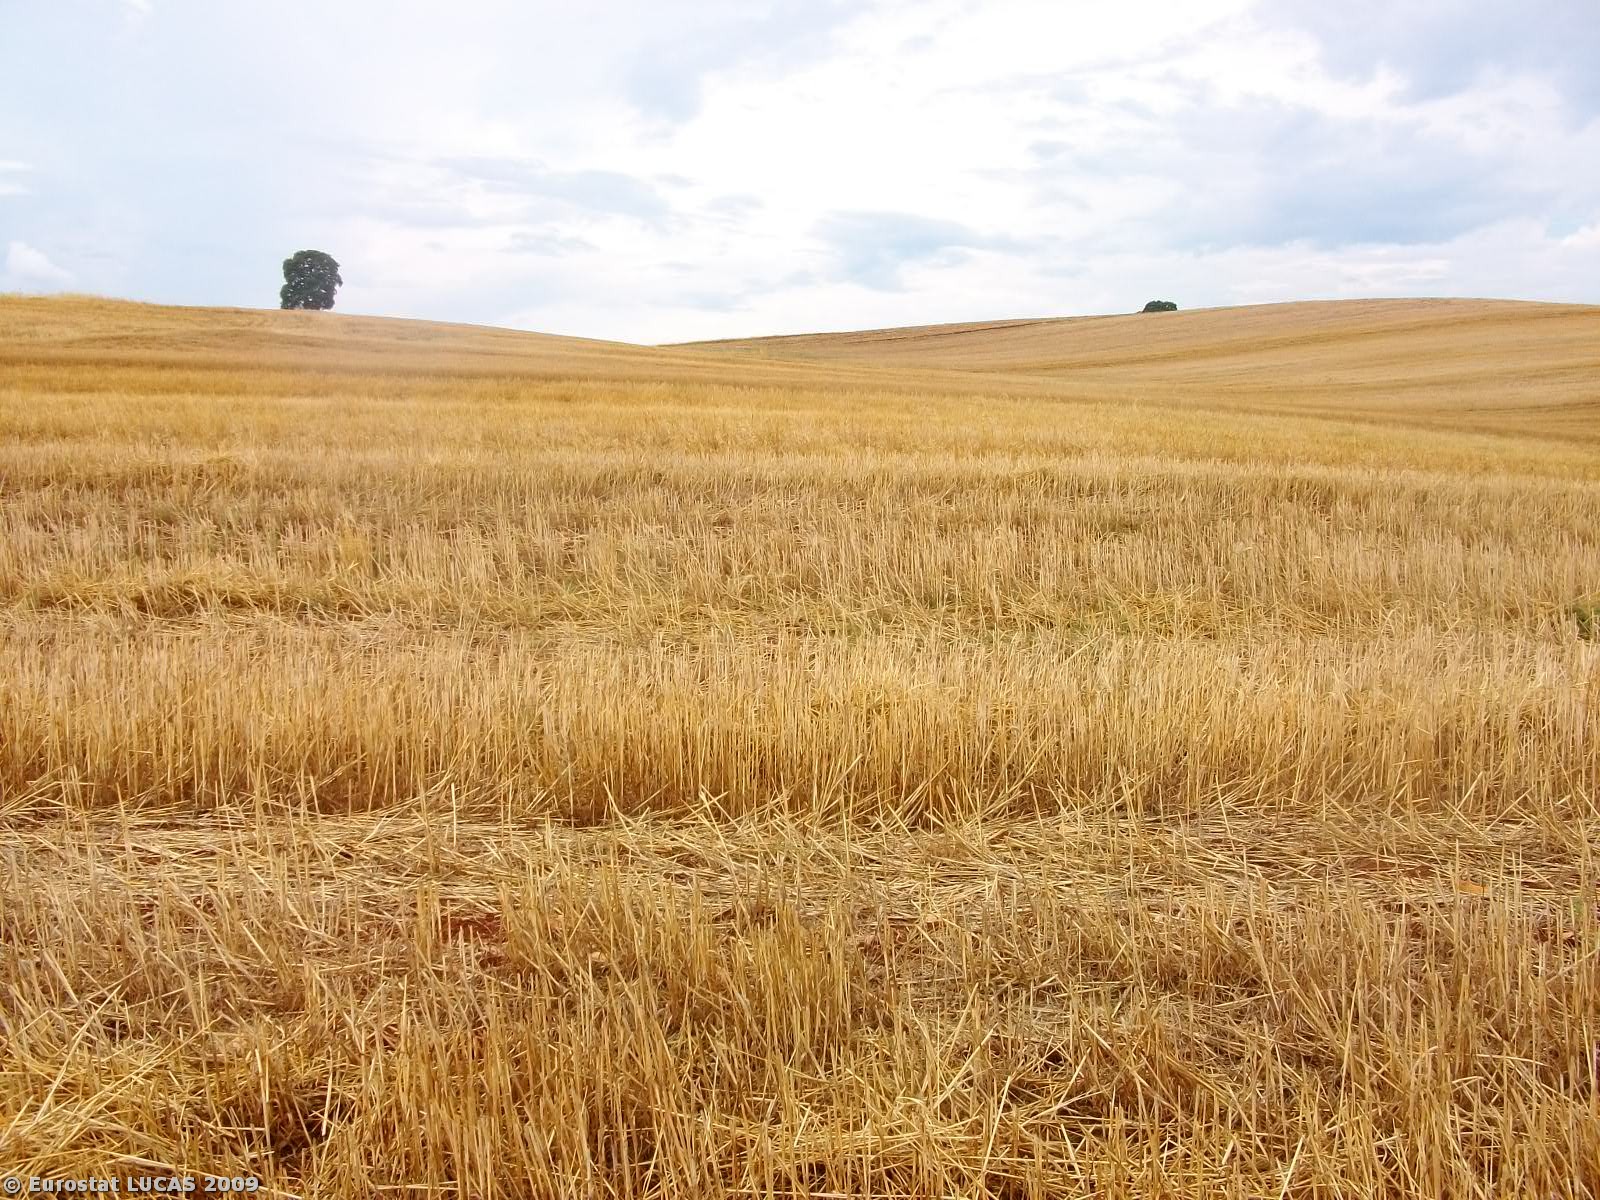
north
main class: Cropland
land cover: Barley
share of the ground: > 75 %
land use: Agriculture (excluding fallow land and kitchen gardens)
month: June
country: GR
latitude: 40.9336
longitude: 22.8721
